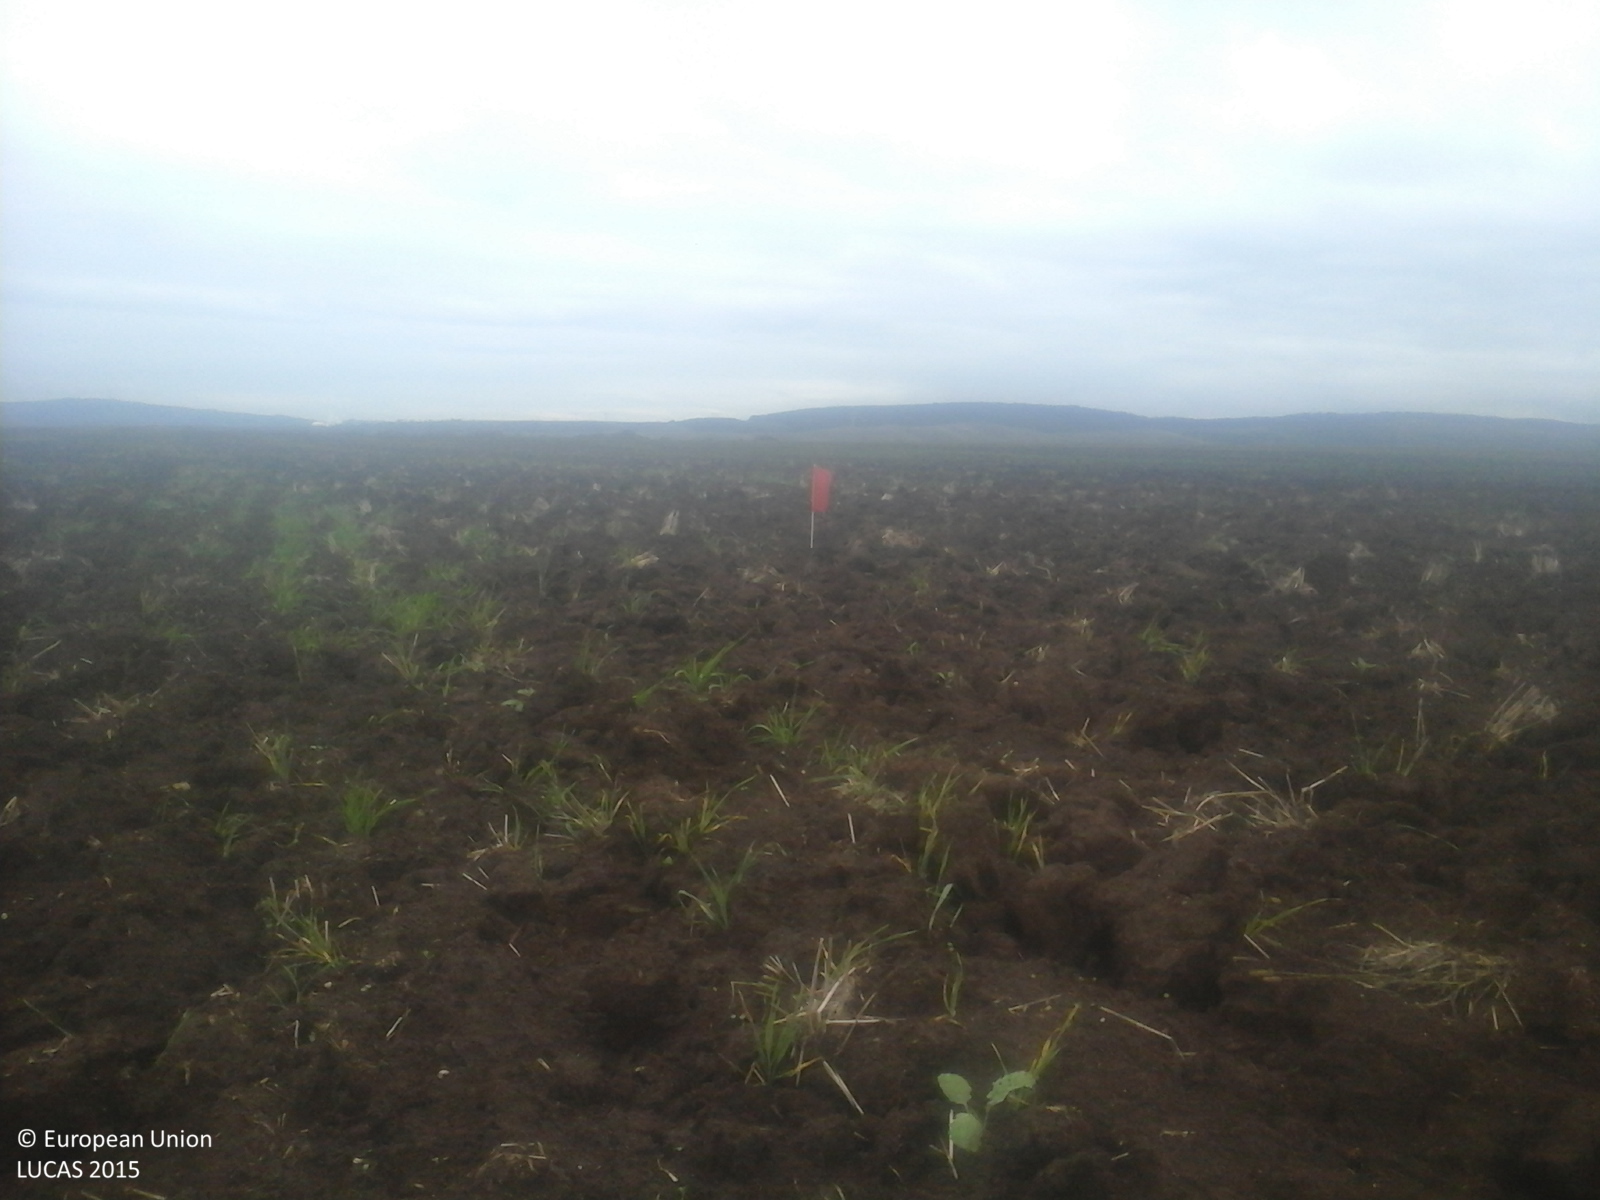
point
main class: Cropland
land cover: Common wheat
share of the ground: < 10 %
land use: Agriculture (excluding fallow land and kitchen gardens)
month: September
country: RO
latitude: 45.9543
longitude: 23.4424
